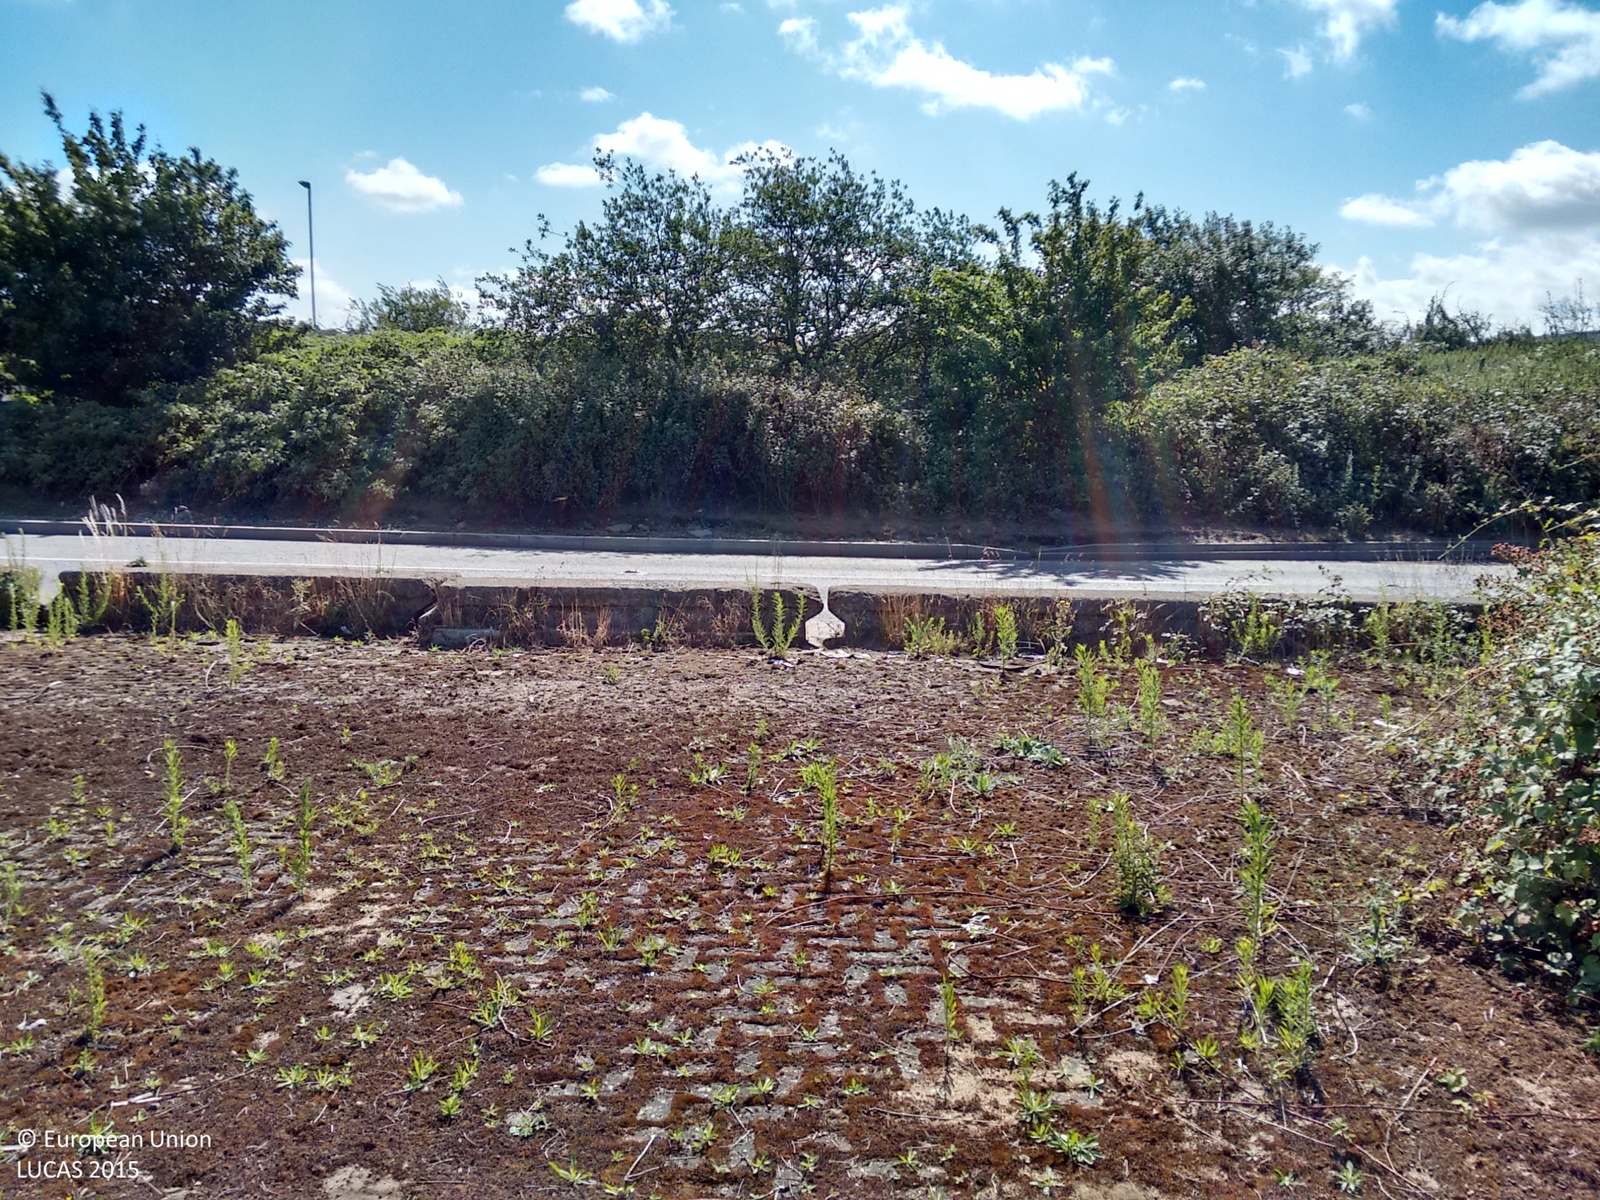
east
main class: Shrubland
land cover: Shrubland without tree cover
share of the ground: > 75 %
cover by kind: shrubs 50 %, herbaceous plants 40 %, consolidated bare surface 10 %
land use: Fallow land
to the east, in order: Shrubland without tree cover; Fences; Grassland without tree/shrub cover; Artificial constructions in urban areas
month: July
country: GB
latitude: 51.3986
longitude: -0.5460
